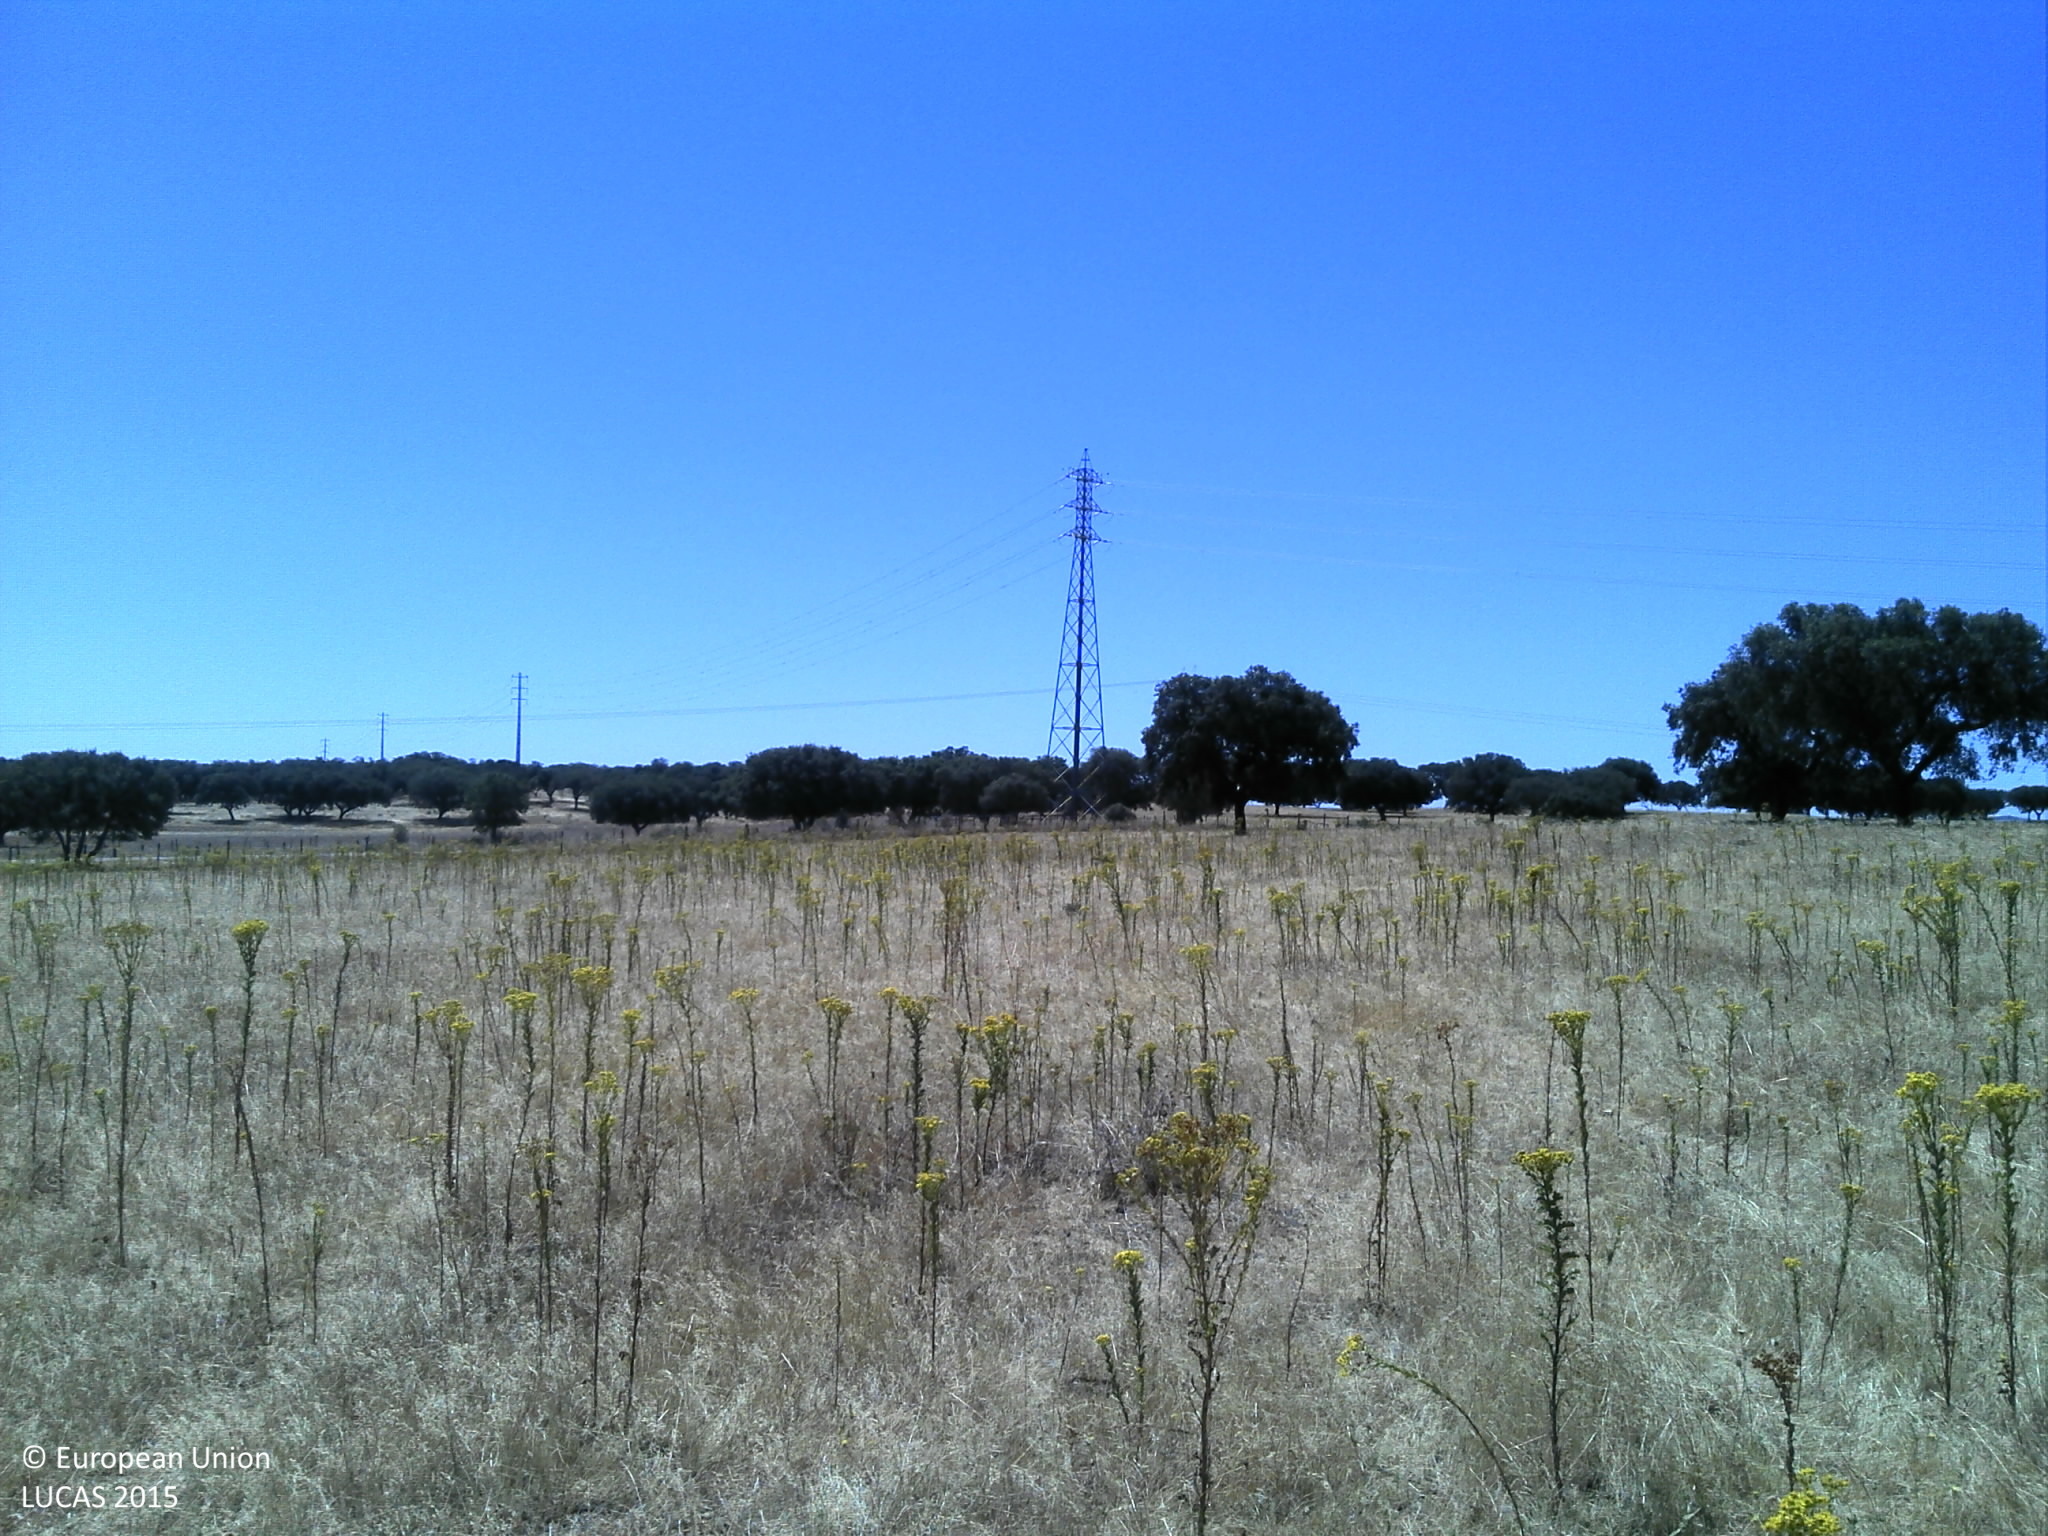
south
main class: Grassland
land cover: Grassland without tree/shrub cover
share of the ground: 25 - 50 %
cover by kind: unconsolidated bare surface 70 %, herbaceous plants 30 %
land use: Agriculture (excluding fallow land and kitchen gardens)
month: July
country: PT
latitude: 38.8784
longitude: -7.4281
